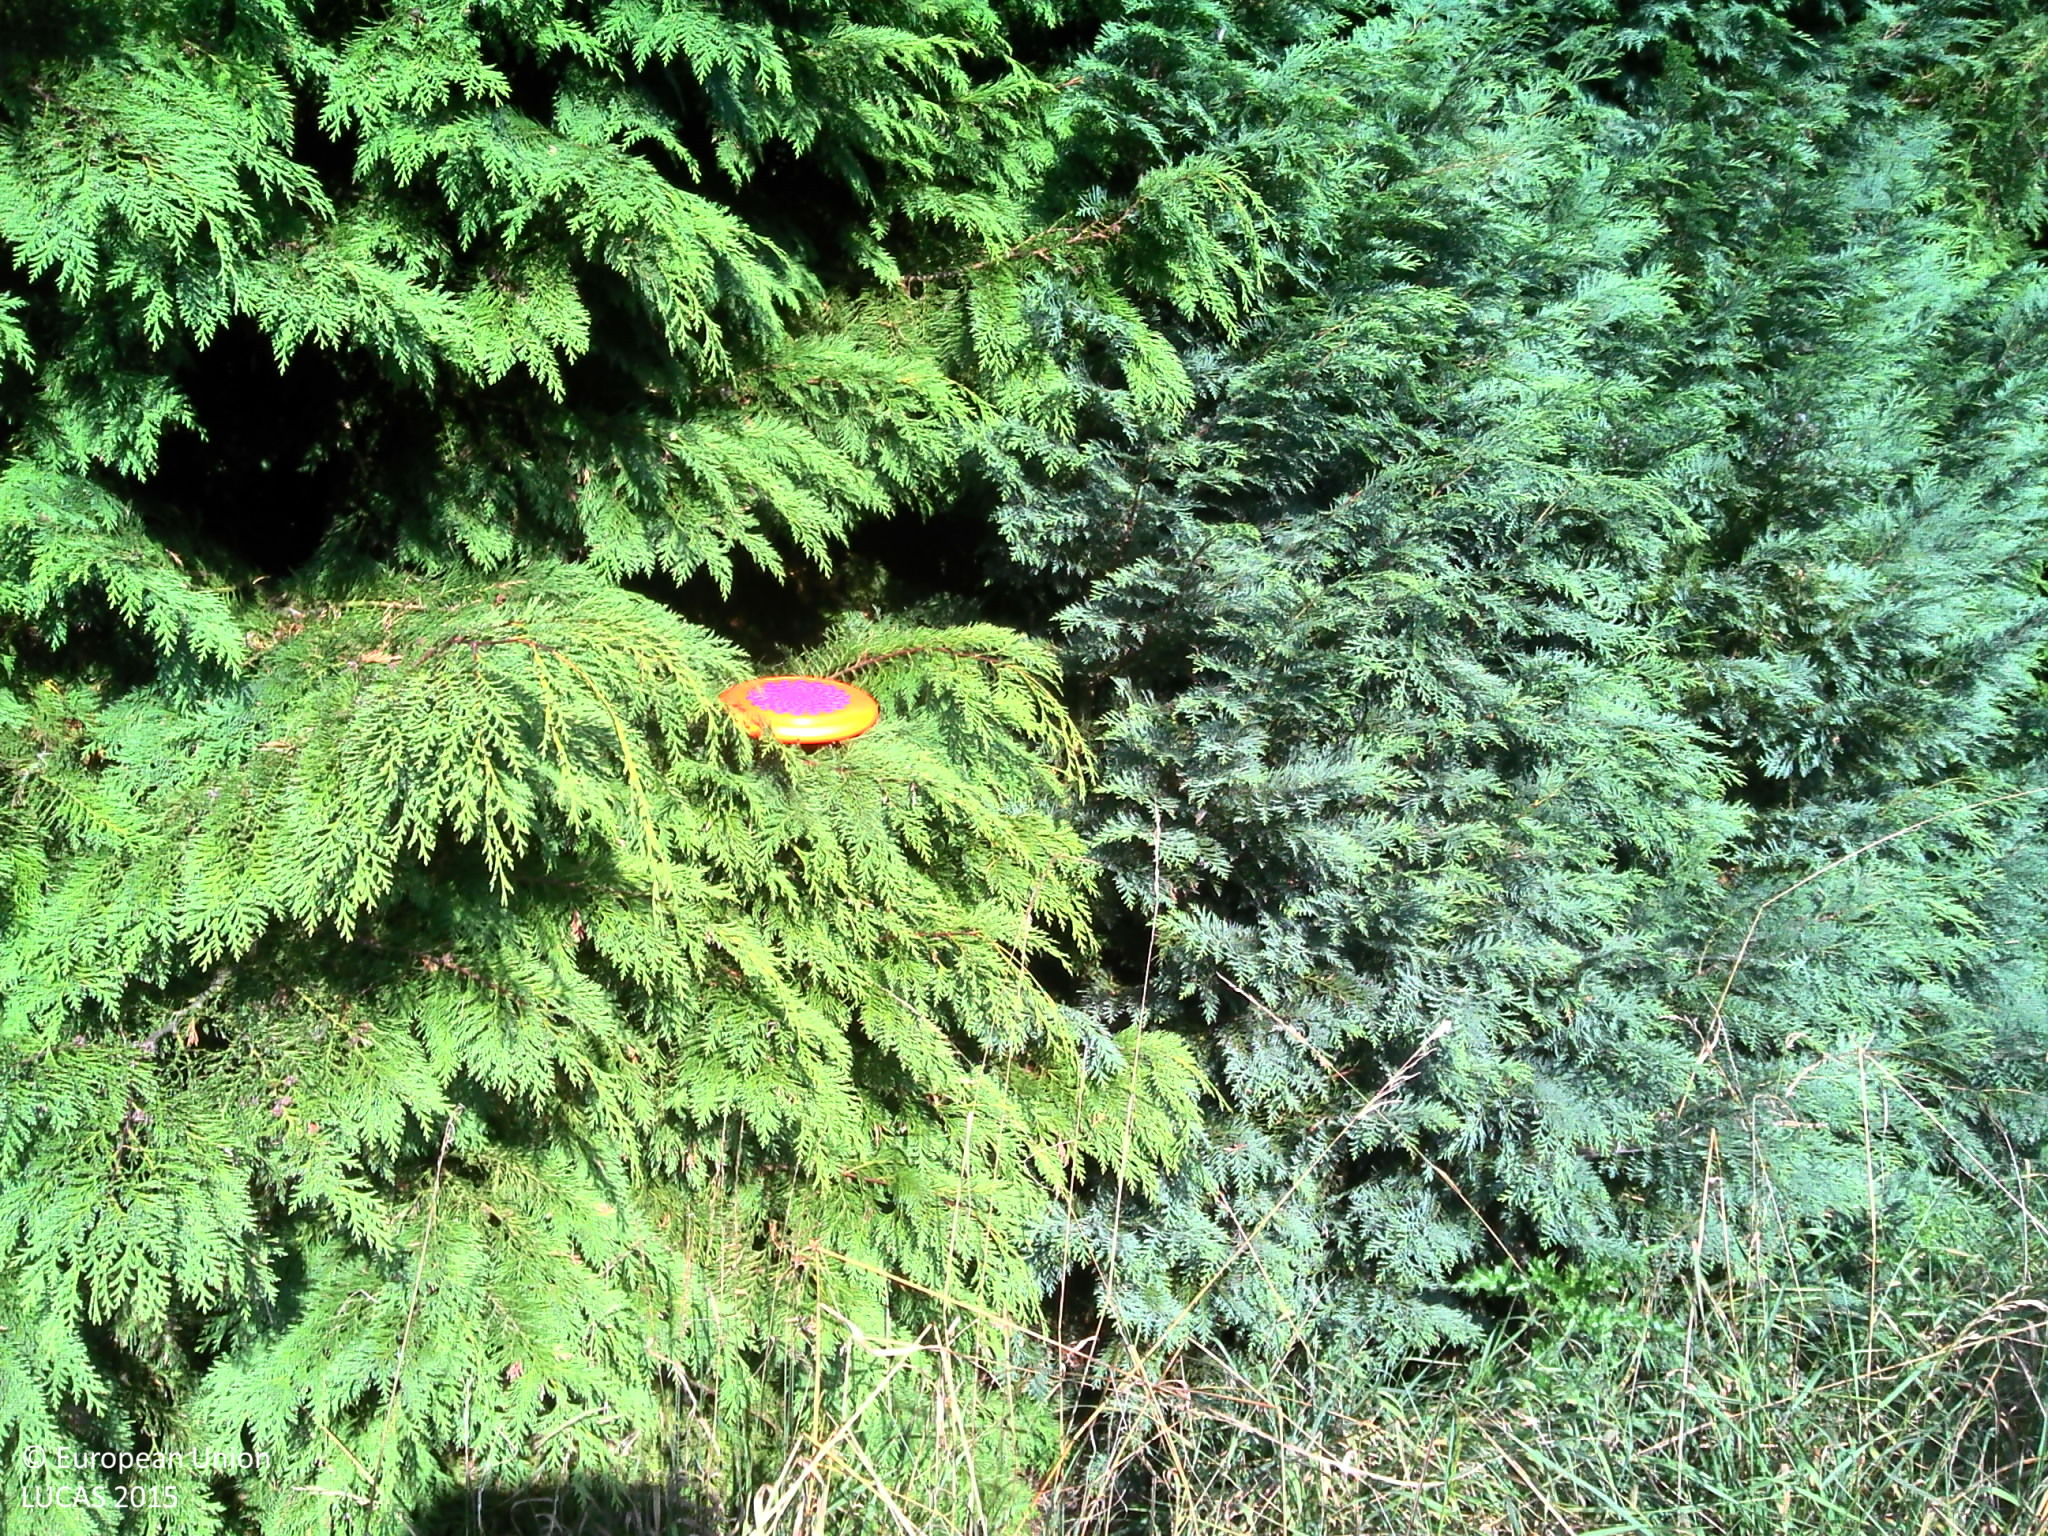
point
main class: Grassland
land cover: Spontaneously vegetated surfaces
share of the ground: > 75 %
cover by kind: herbaceous plants 100 %
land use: Residential
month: August
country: BE
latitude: 51.1810
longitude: 5.1765
